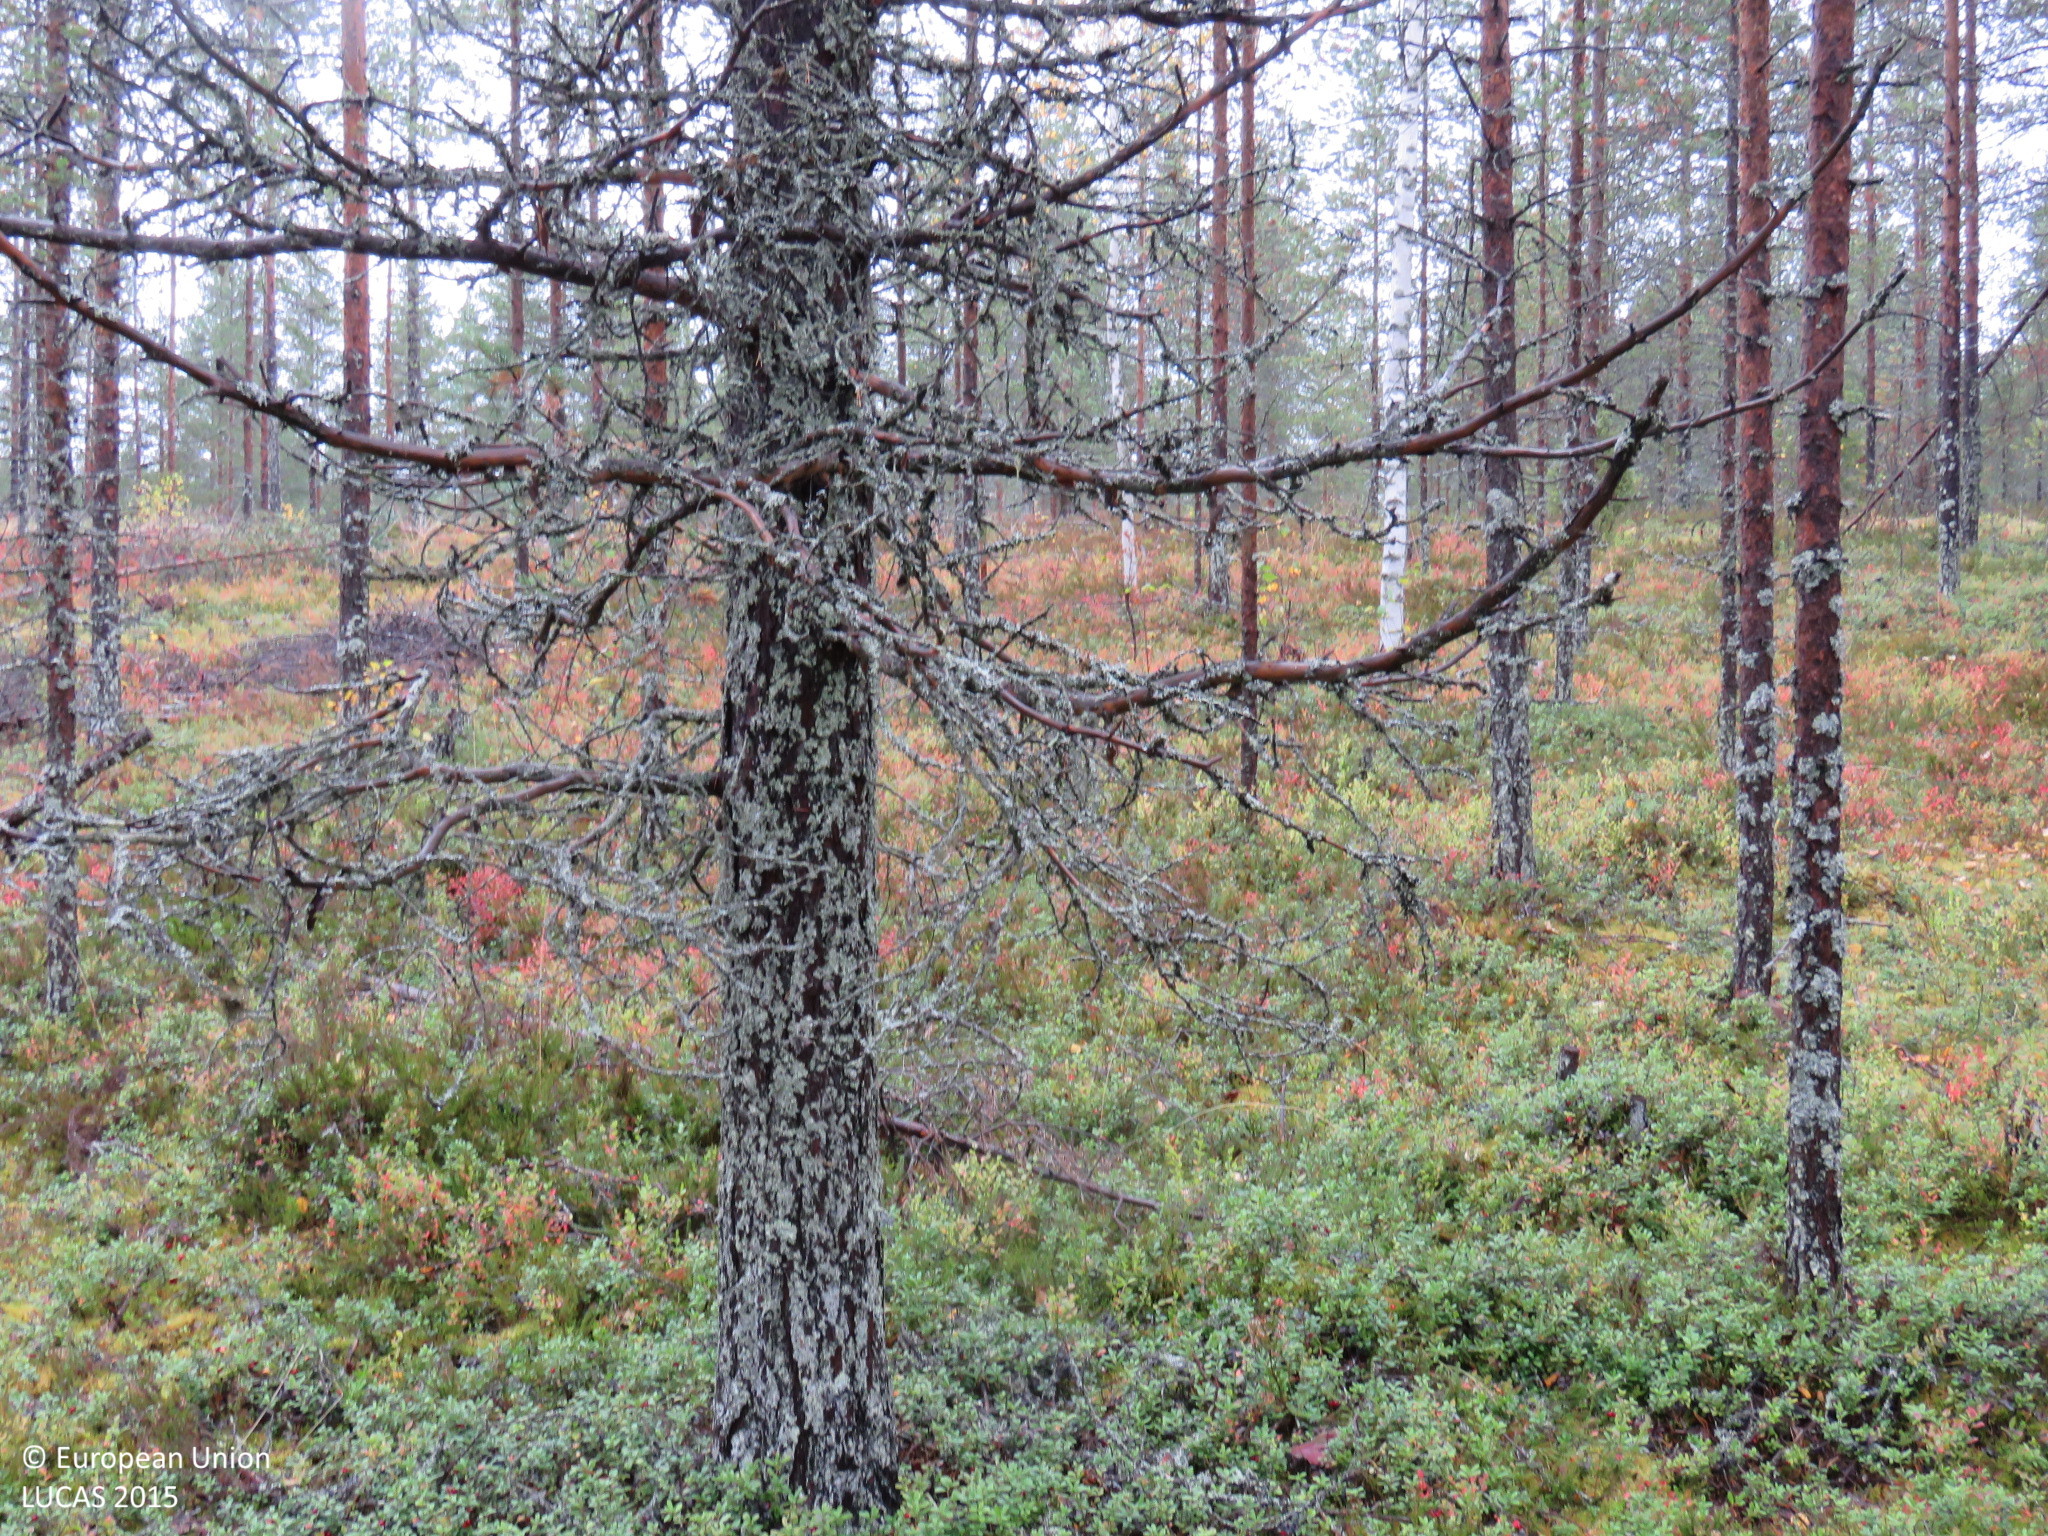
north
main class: Woodland
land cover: Pine dominated coniferous woodland
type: boreal forest
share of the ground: > 75 %
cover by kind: coniferous forest trees 70 %, shrubs 20 %, broadleaved forest trees 5 %, lichens and mosses 5 %
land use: Forestry
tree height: > 5 m
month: September
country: FI
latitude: 65.1181
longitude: 26.7052
